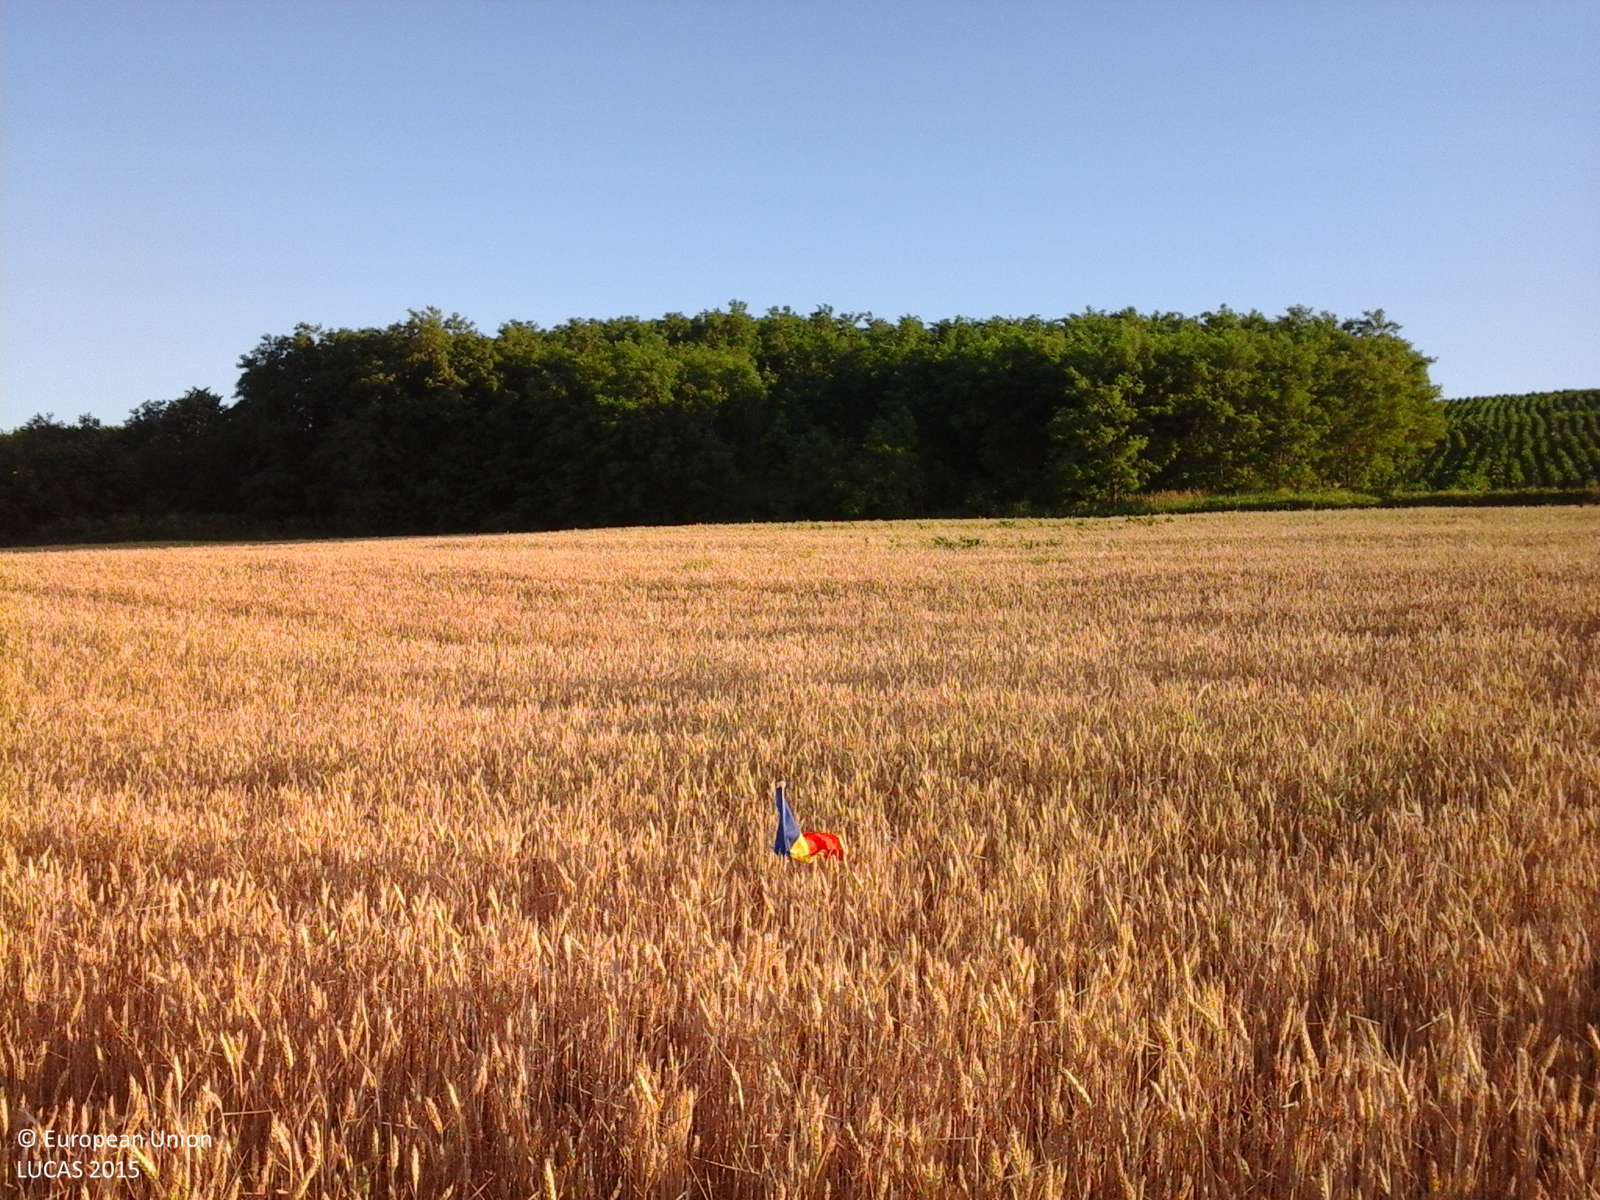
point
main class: Cropland
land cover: Common wheat
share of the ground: > 75 %
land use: Agriculture (excluding fallow land and kitchen gardens)
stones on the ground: < 10 %
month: June
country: RO
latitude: 46.9664
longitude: 27.9911
